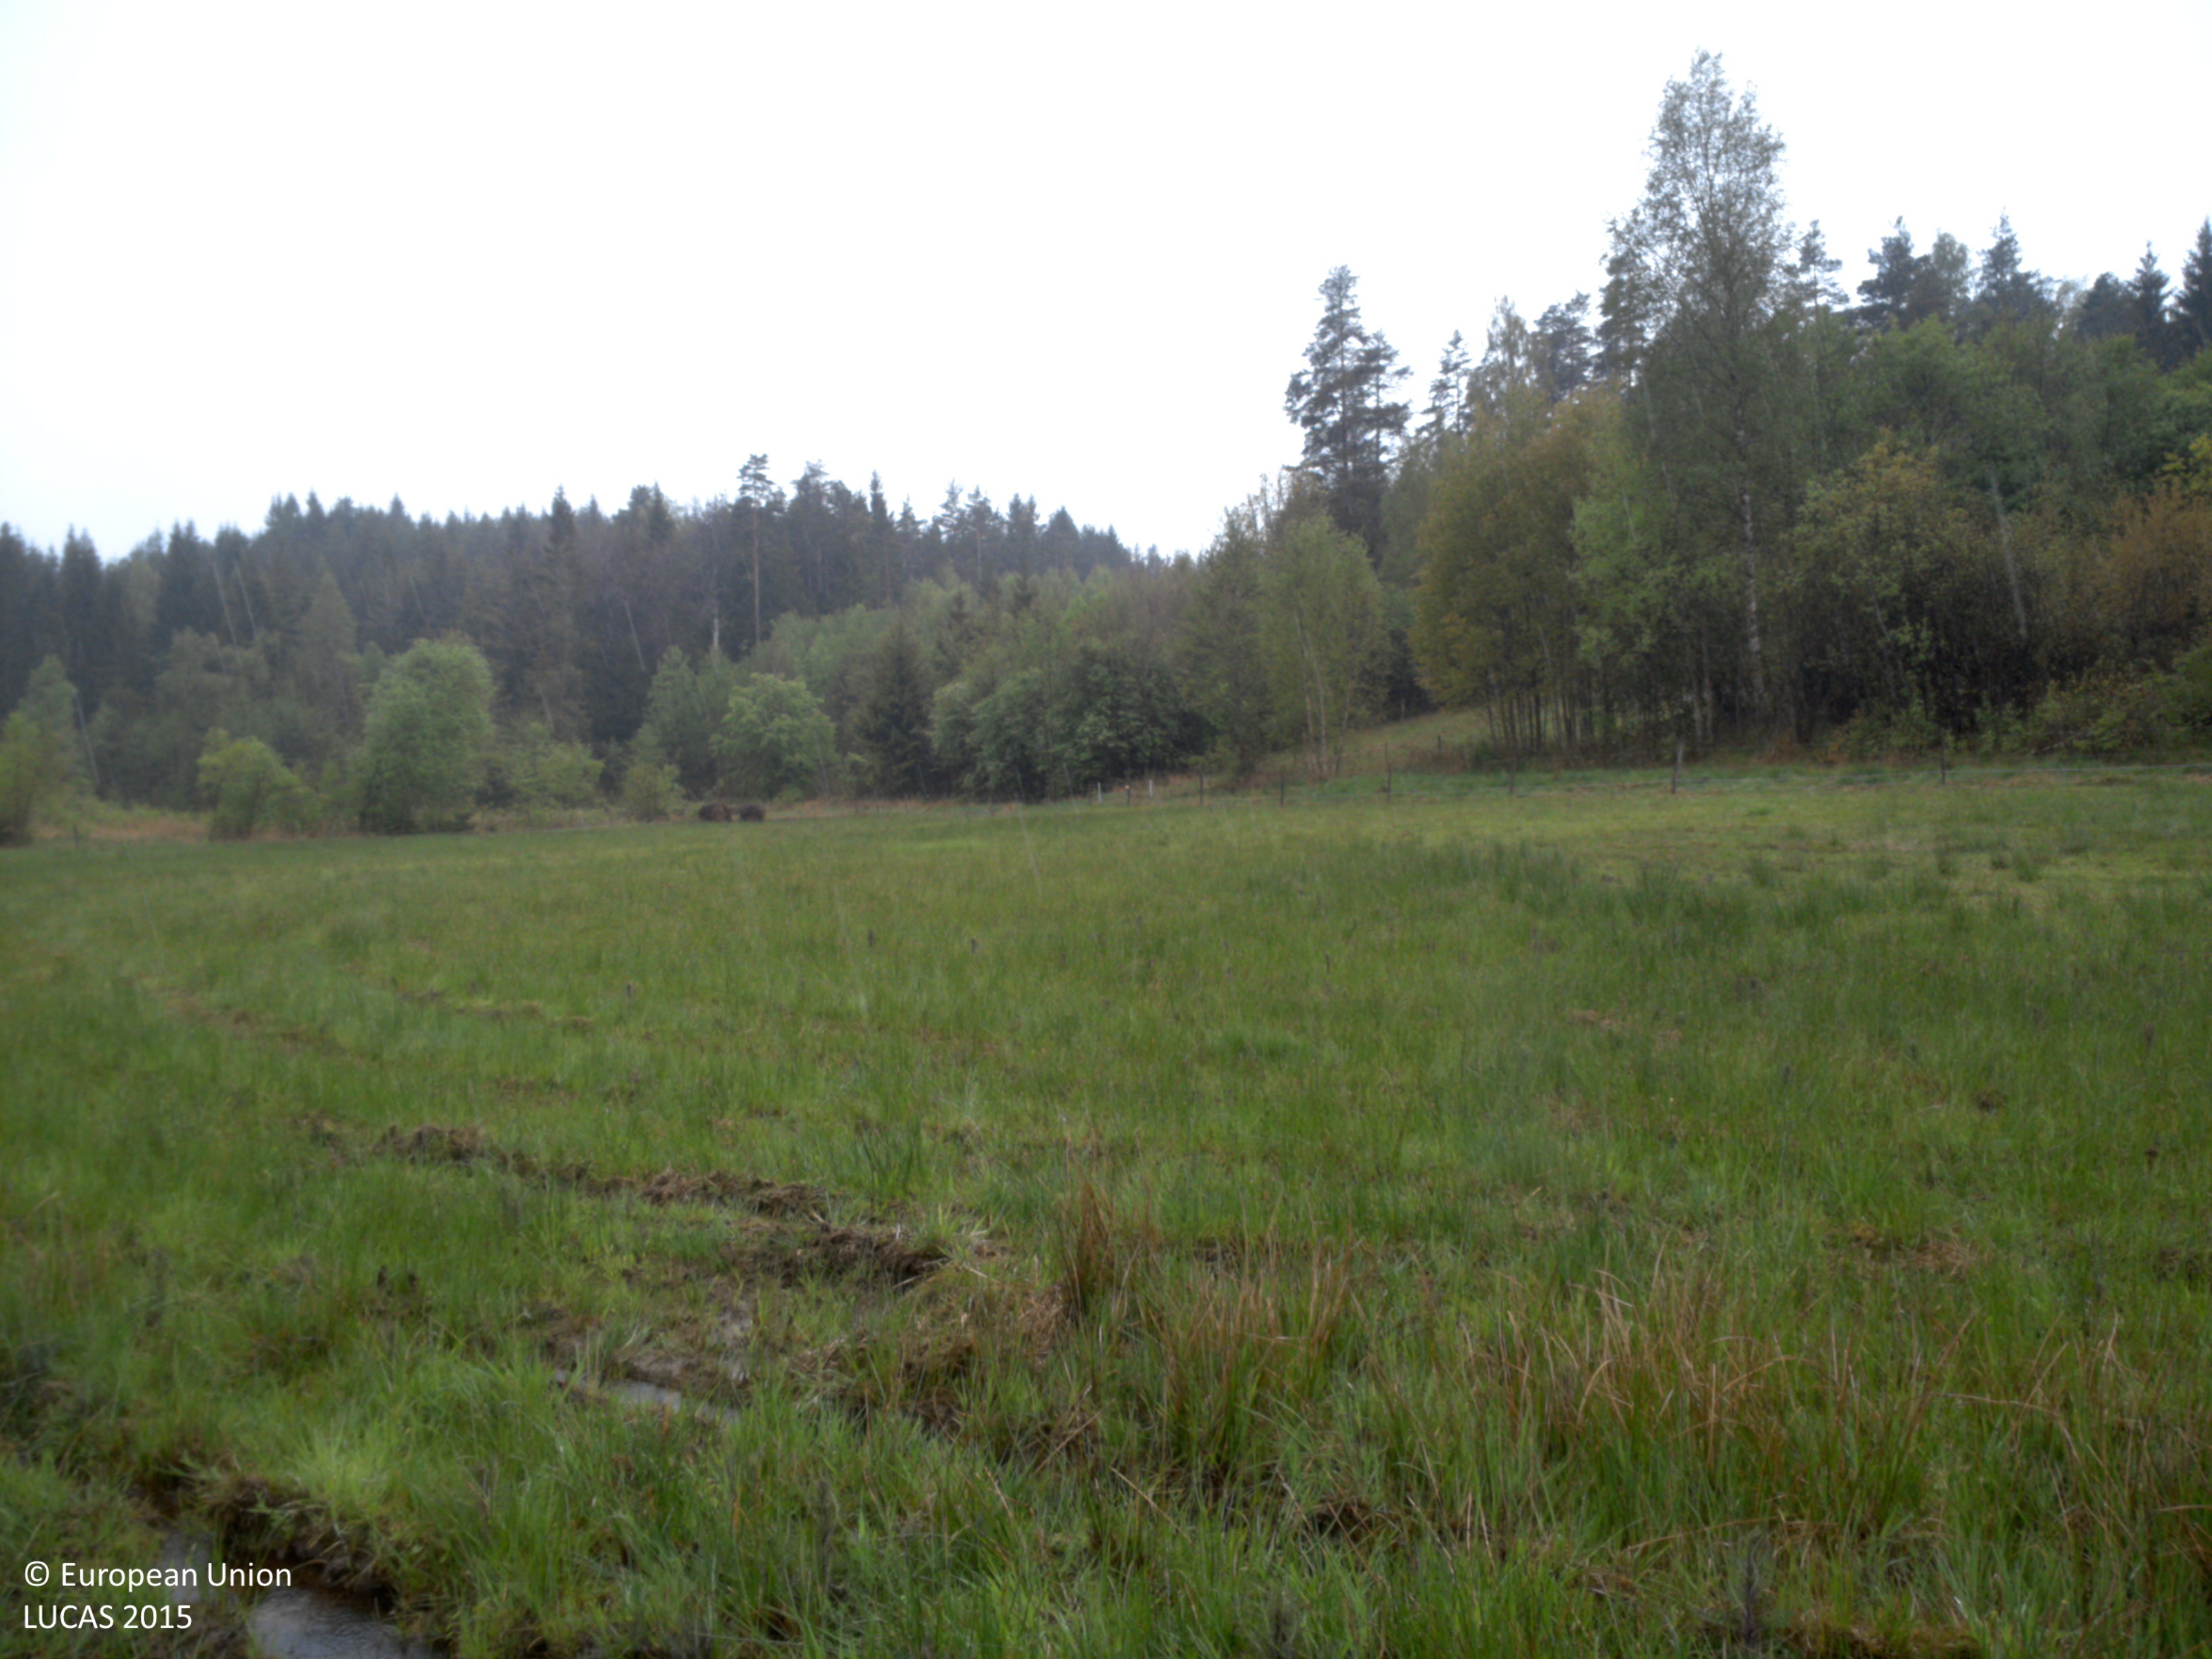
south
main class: Grassland
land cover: Grassland without tree/shrub cover
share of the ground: > 75 %
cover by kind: herbaceous plants 100 %
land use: Agriculture (excluding fallow land and kitchen gardens)
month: May
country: SE
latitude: 58.3708
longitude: 11.6891
